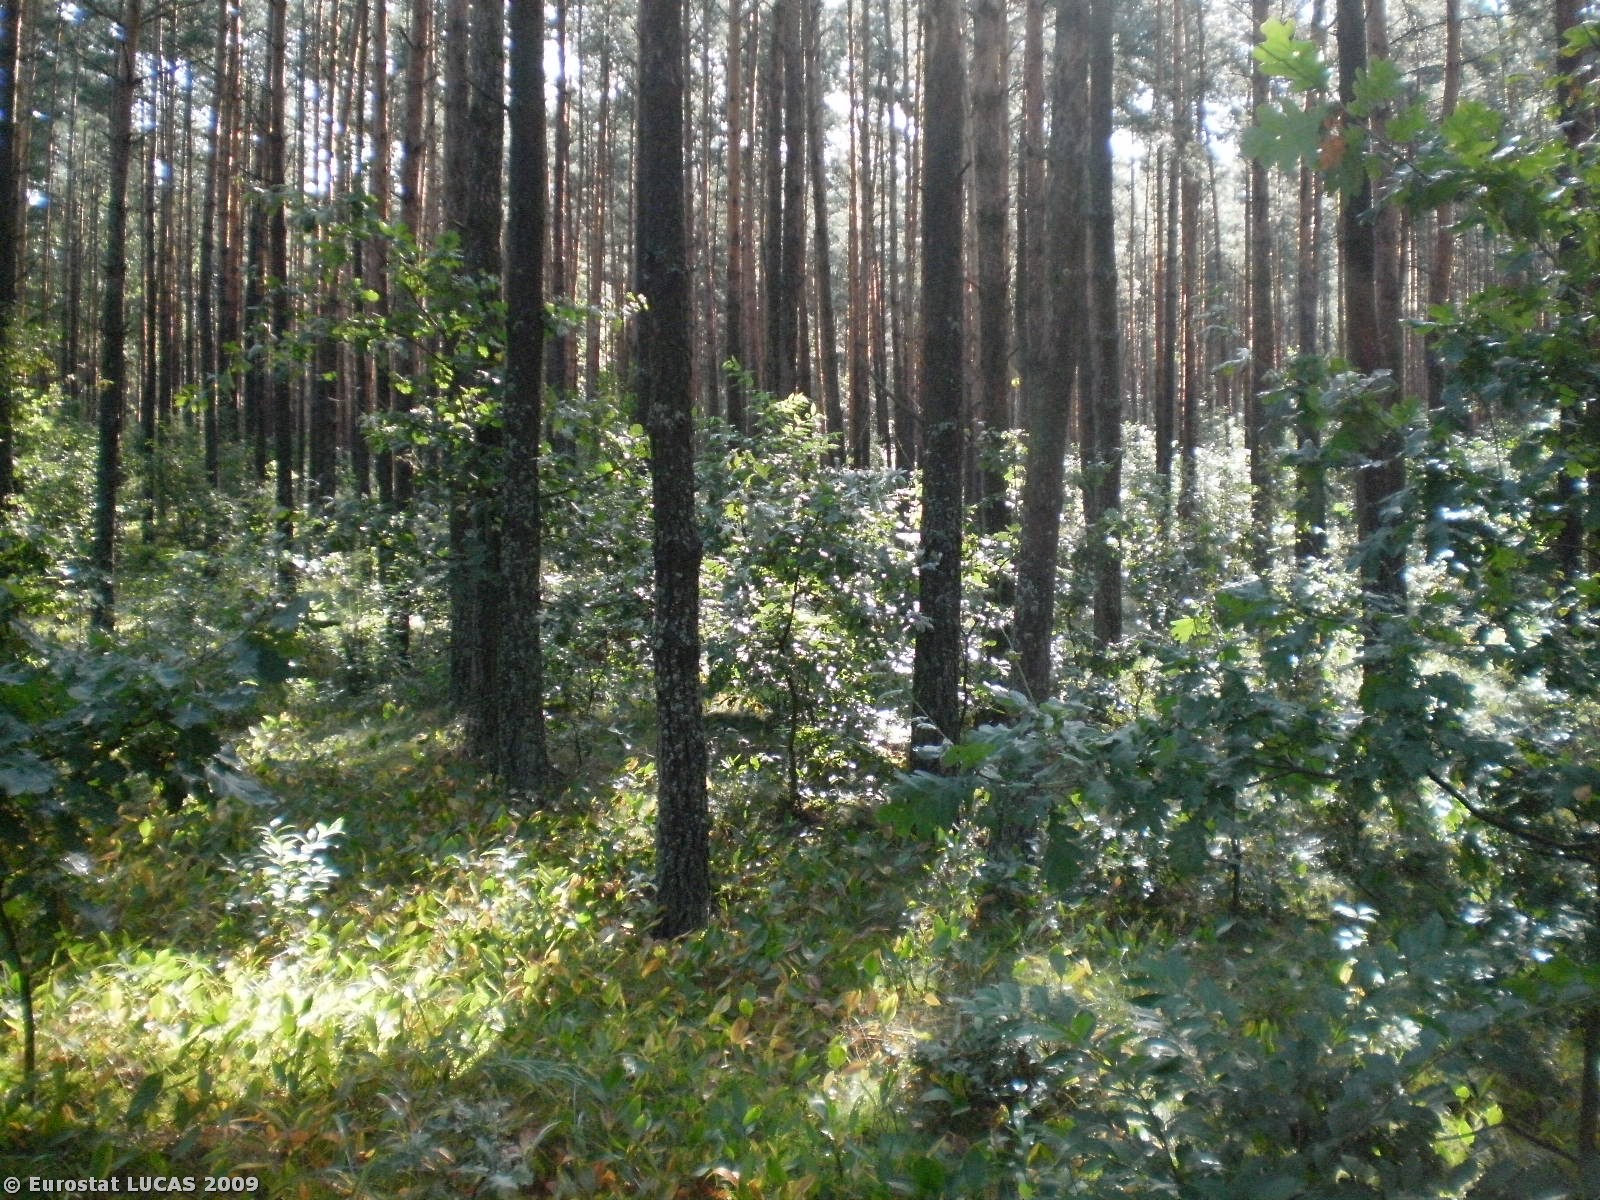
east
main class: Woodland
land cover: Coniferous woodland
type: hemiboreal forest and nemoral coniferous forest and mixed broadleaved-coniferous forest
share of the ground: > 75 %
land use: Forestry
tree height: > 5 m
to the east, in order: Coniferous woodland
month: August
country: PL
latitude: 52.7586
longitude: 21.1446
